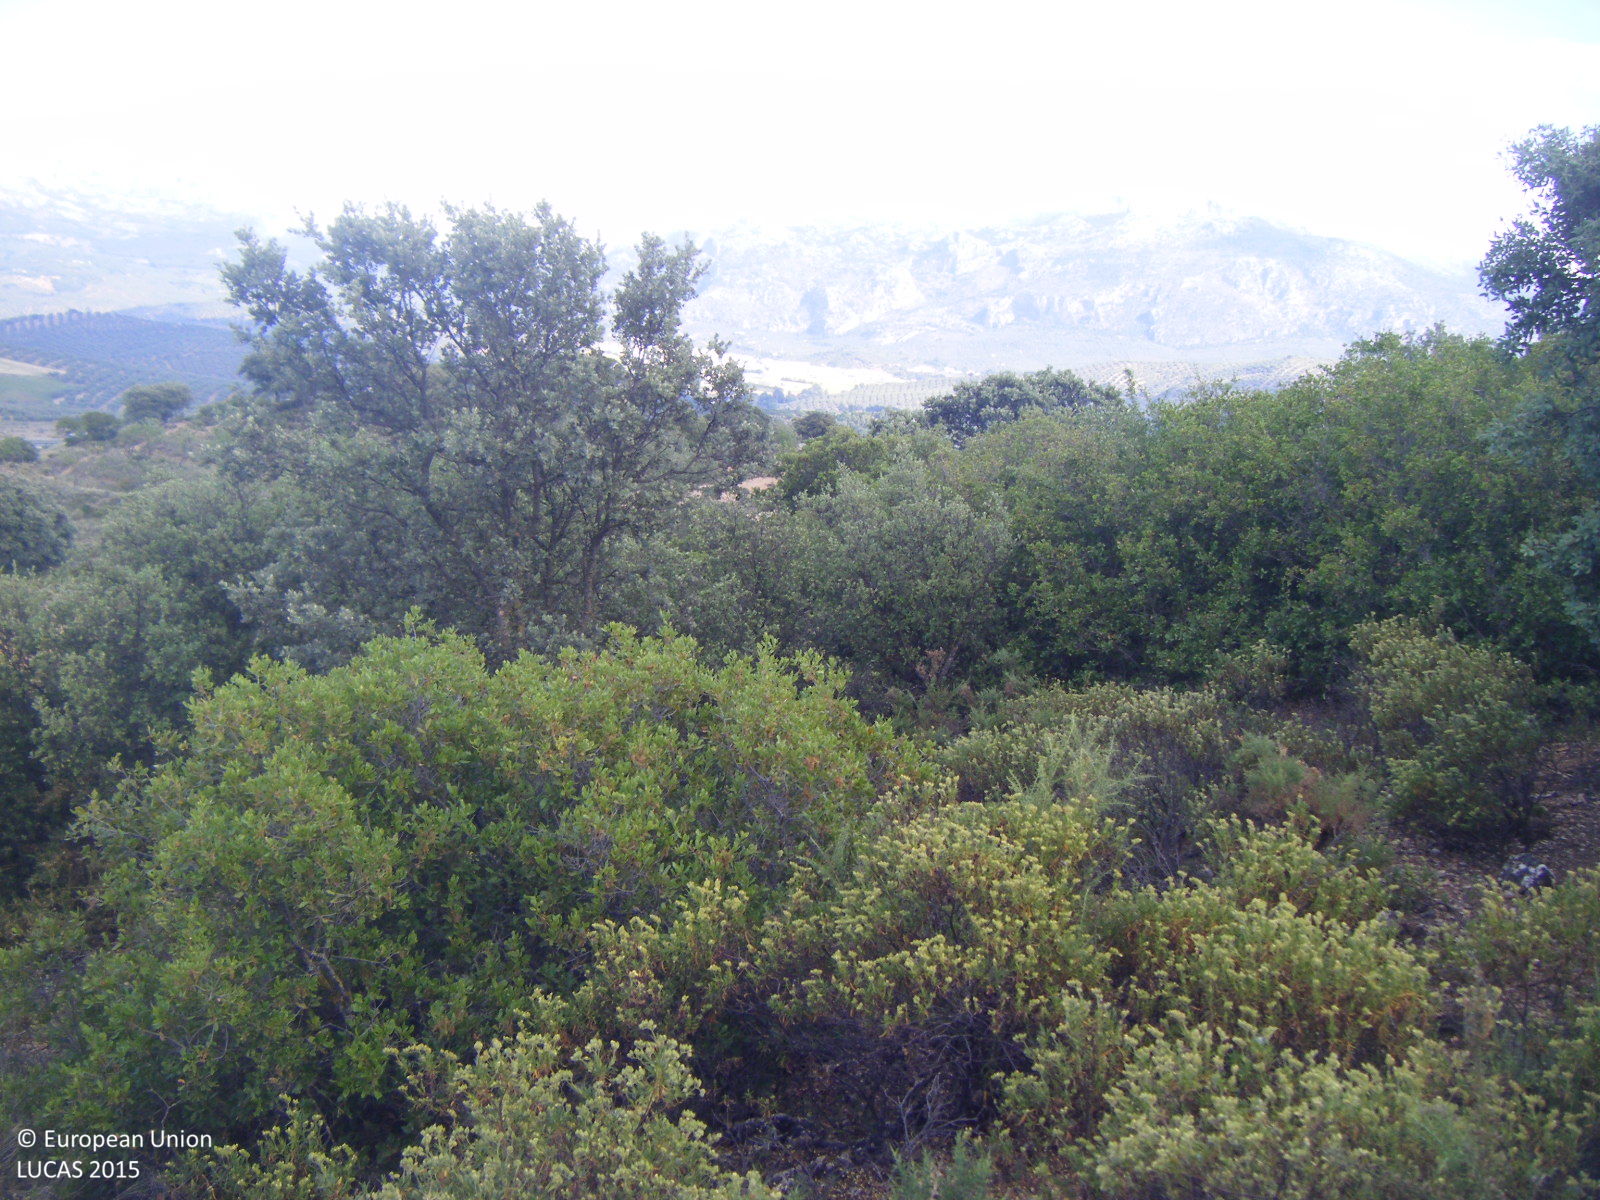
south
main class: Woodland
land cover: Broadleaved woodland
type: broadleaved evergreen forest
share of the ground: 10 - 25 %
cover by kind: shrubs 85 %, broadleaved forest trees 15 %
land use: Semi-natural and natural areas not in use
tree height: < 5 m
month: May
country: ES
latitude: 37.0322
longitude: -4.3957
